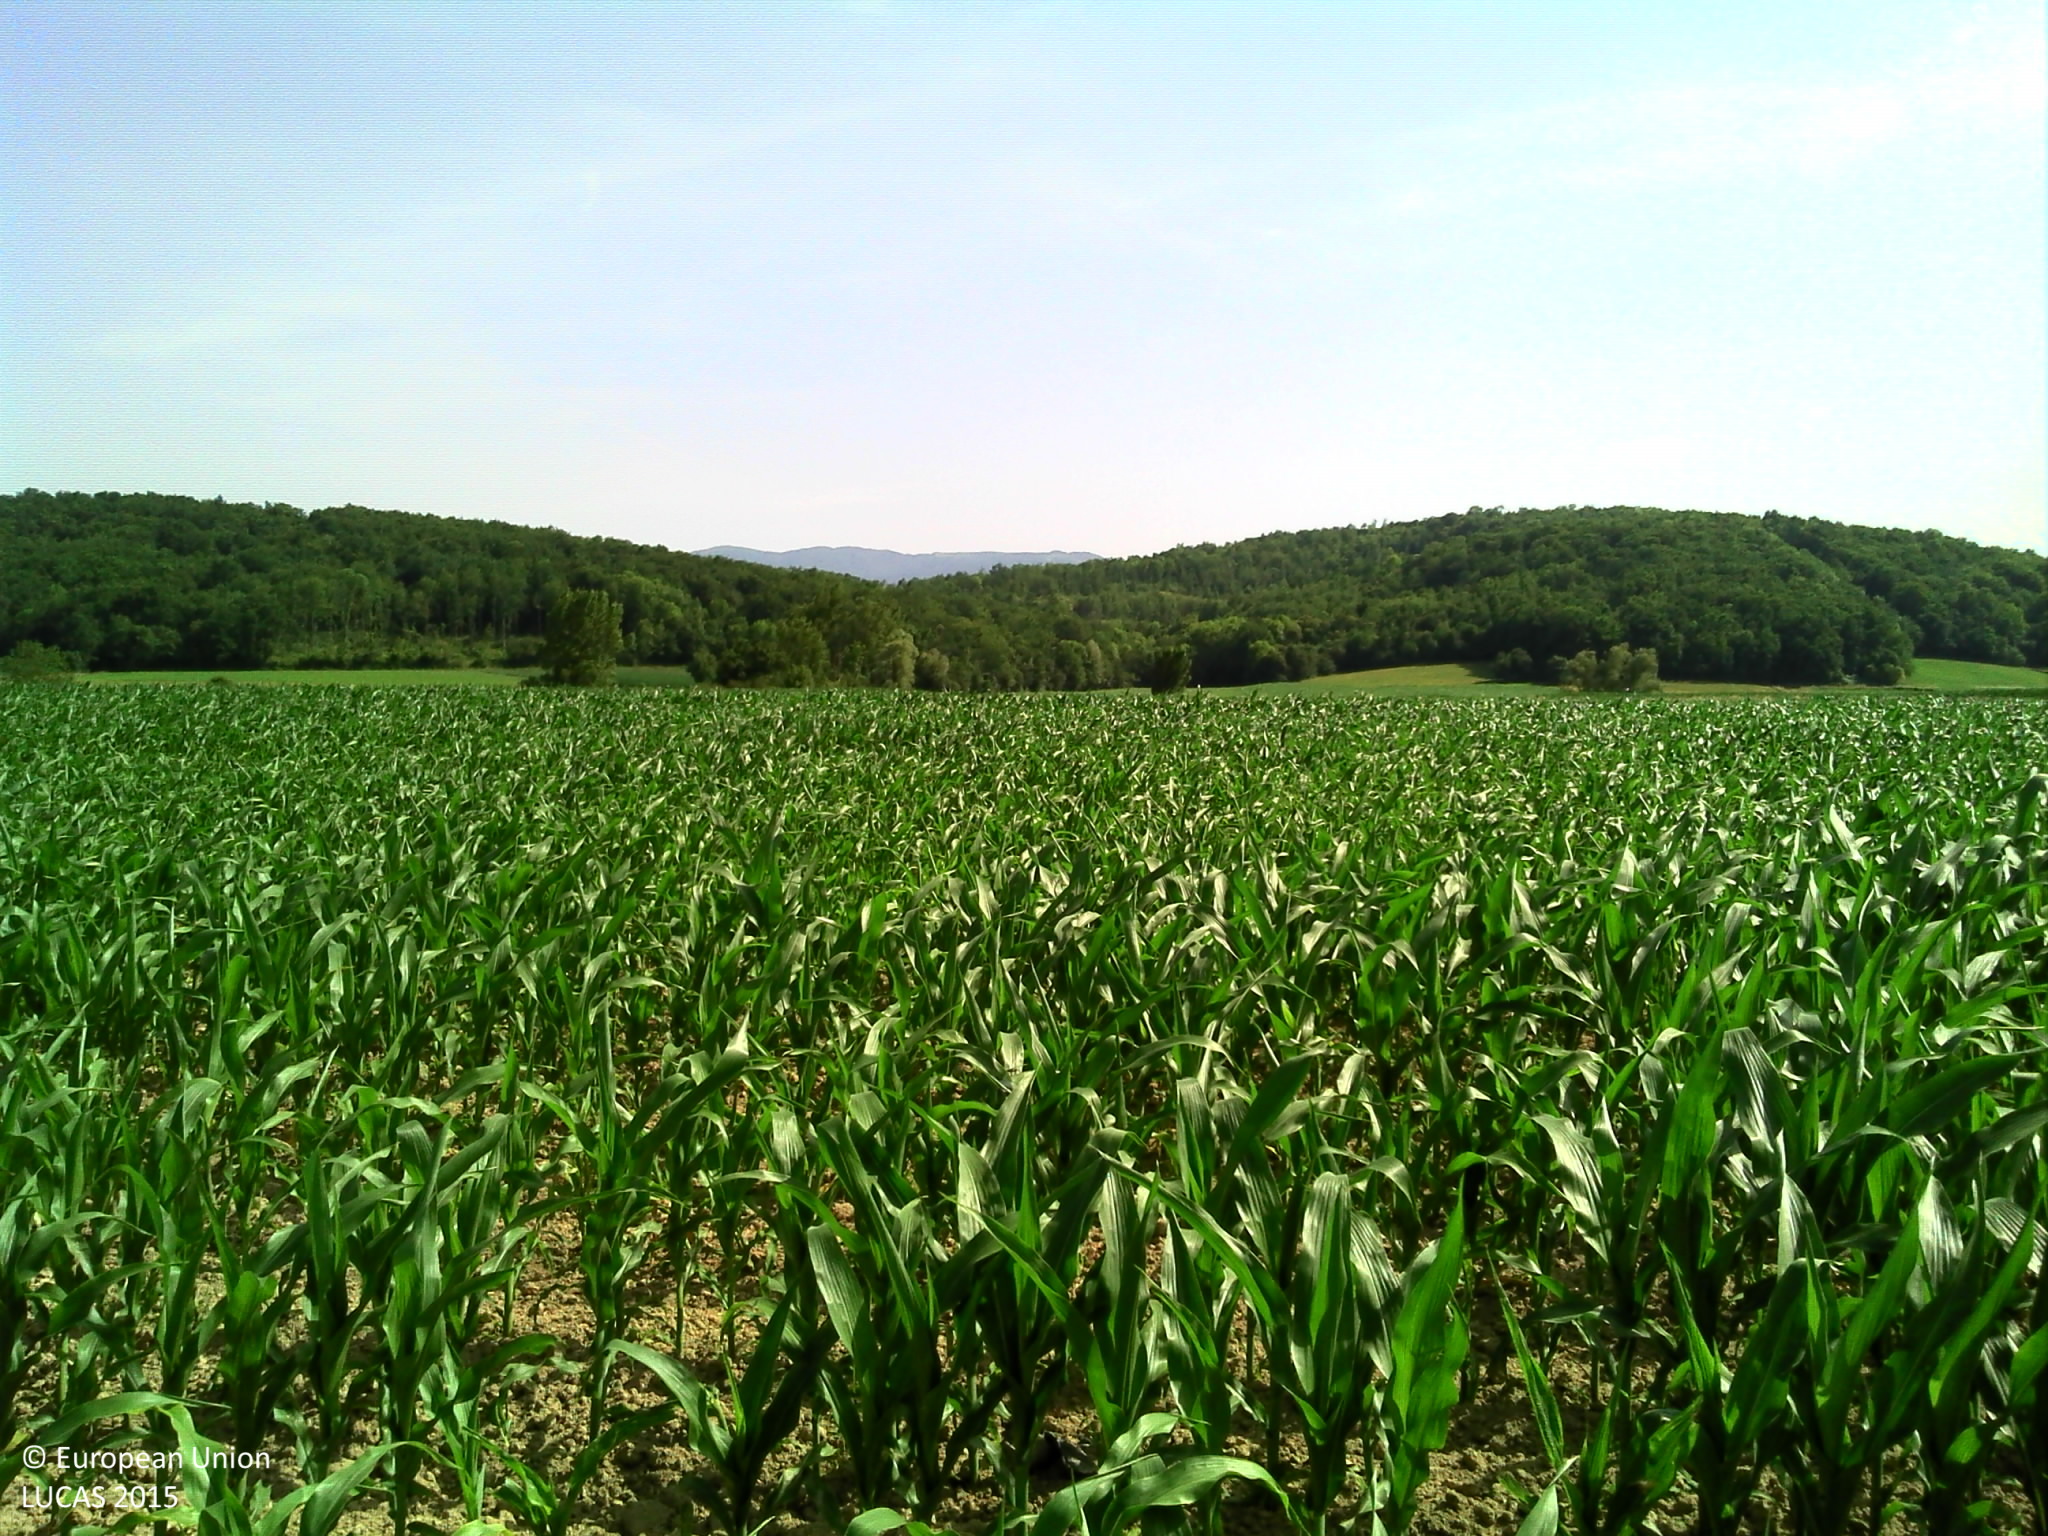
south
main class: Cropland
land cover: Maize
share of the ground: 50 - 75 %
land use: Agriculture (excluding fallow land and kitchen gardens)
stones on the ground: < 10 %
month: July
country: FR
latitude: 43.0948
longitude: 0.8745
